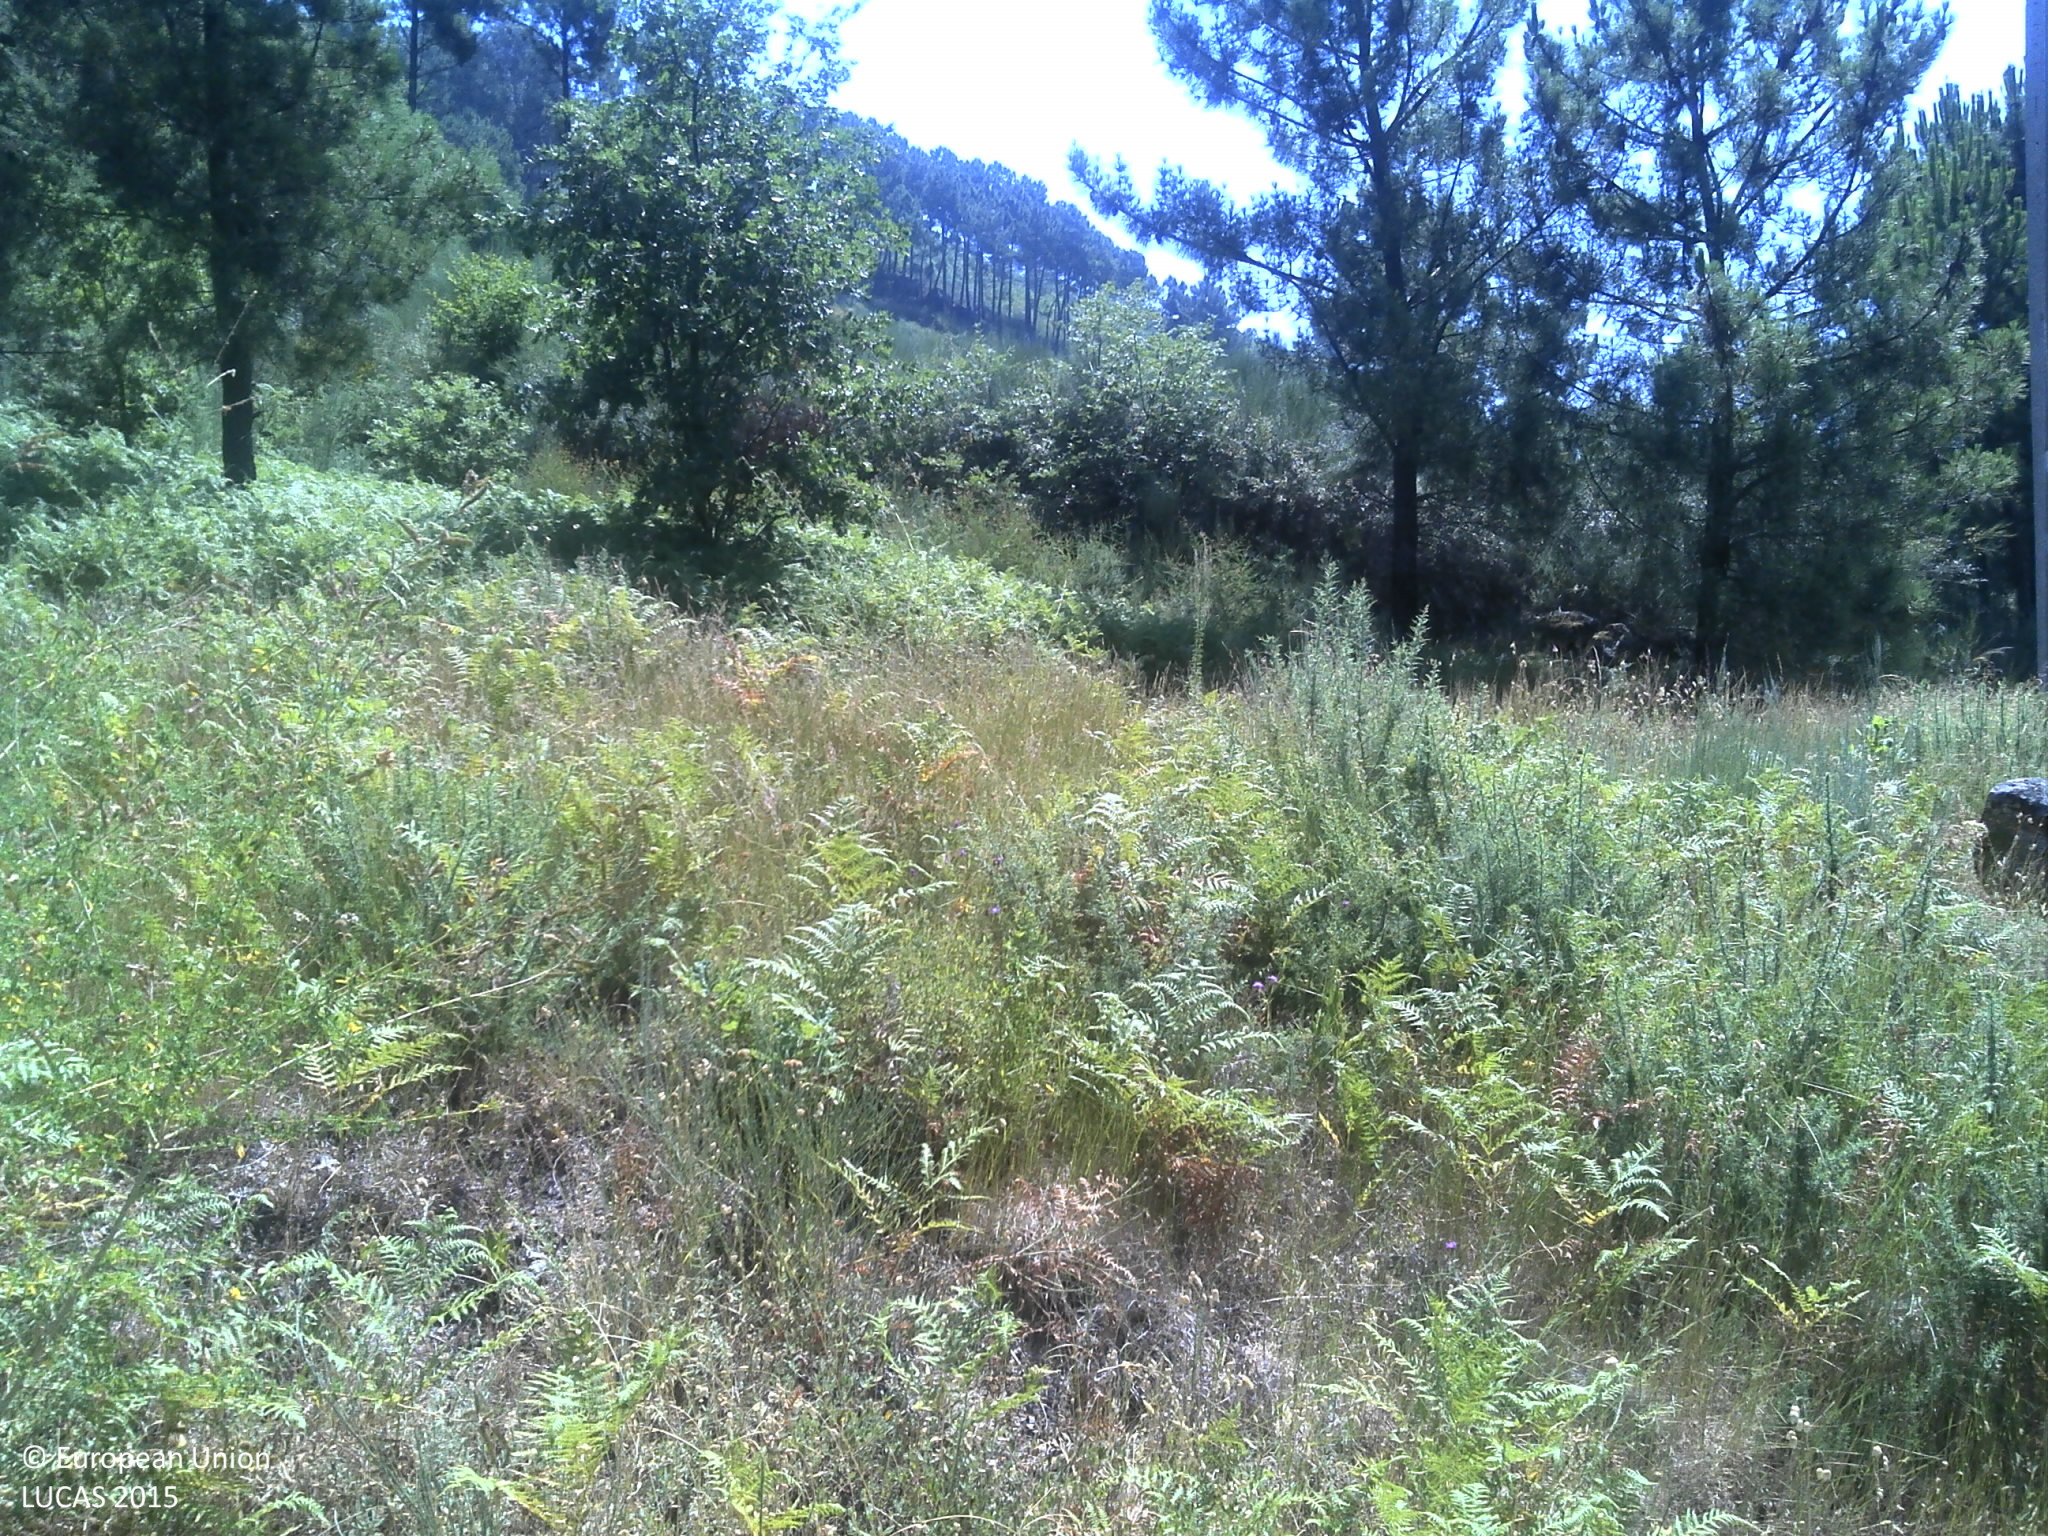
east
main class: Shrubland
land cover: Shrubland with sparse tree cover
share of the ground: 50 - 75 %
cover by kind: shrubs 60 %, herbaceous plants 20 %, consolidated bare surface 10 %, broadleaved forest trees 5 %, unconsolidated bare surface 5 %
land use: Agriculture (excluding fallow land and kitchen gardens)
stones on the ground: 25 - 50 %
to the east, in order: Shrubland with sparse tree cover; Electric lines; Grass margins; Paved roads, cycling and walking lanes; Shrubland with sparse tree cover; Shrubland without tree cover; Shrubland with sparse tree cover; Pine dominated coniferous woodland
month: June
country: PT
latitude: 41.1638
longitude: -7.9514
